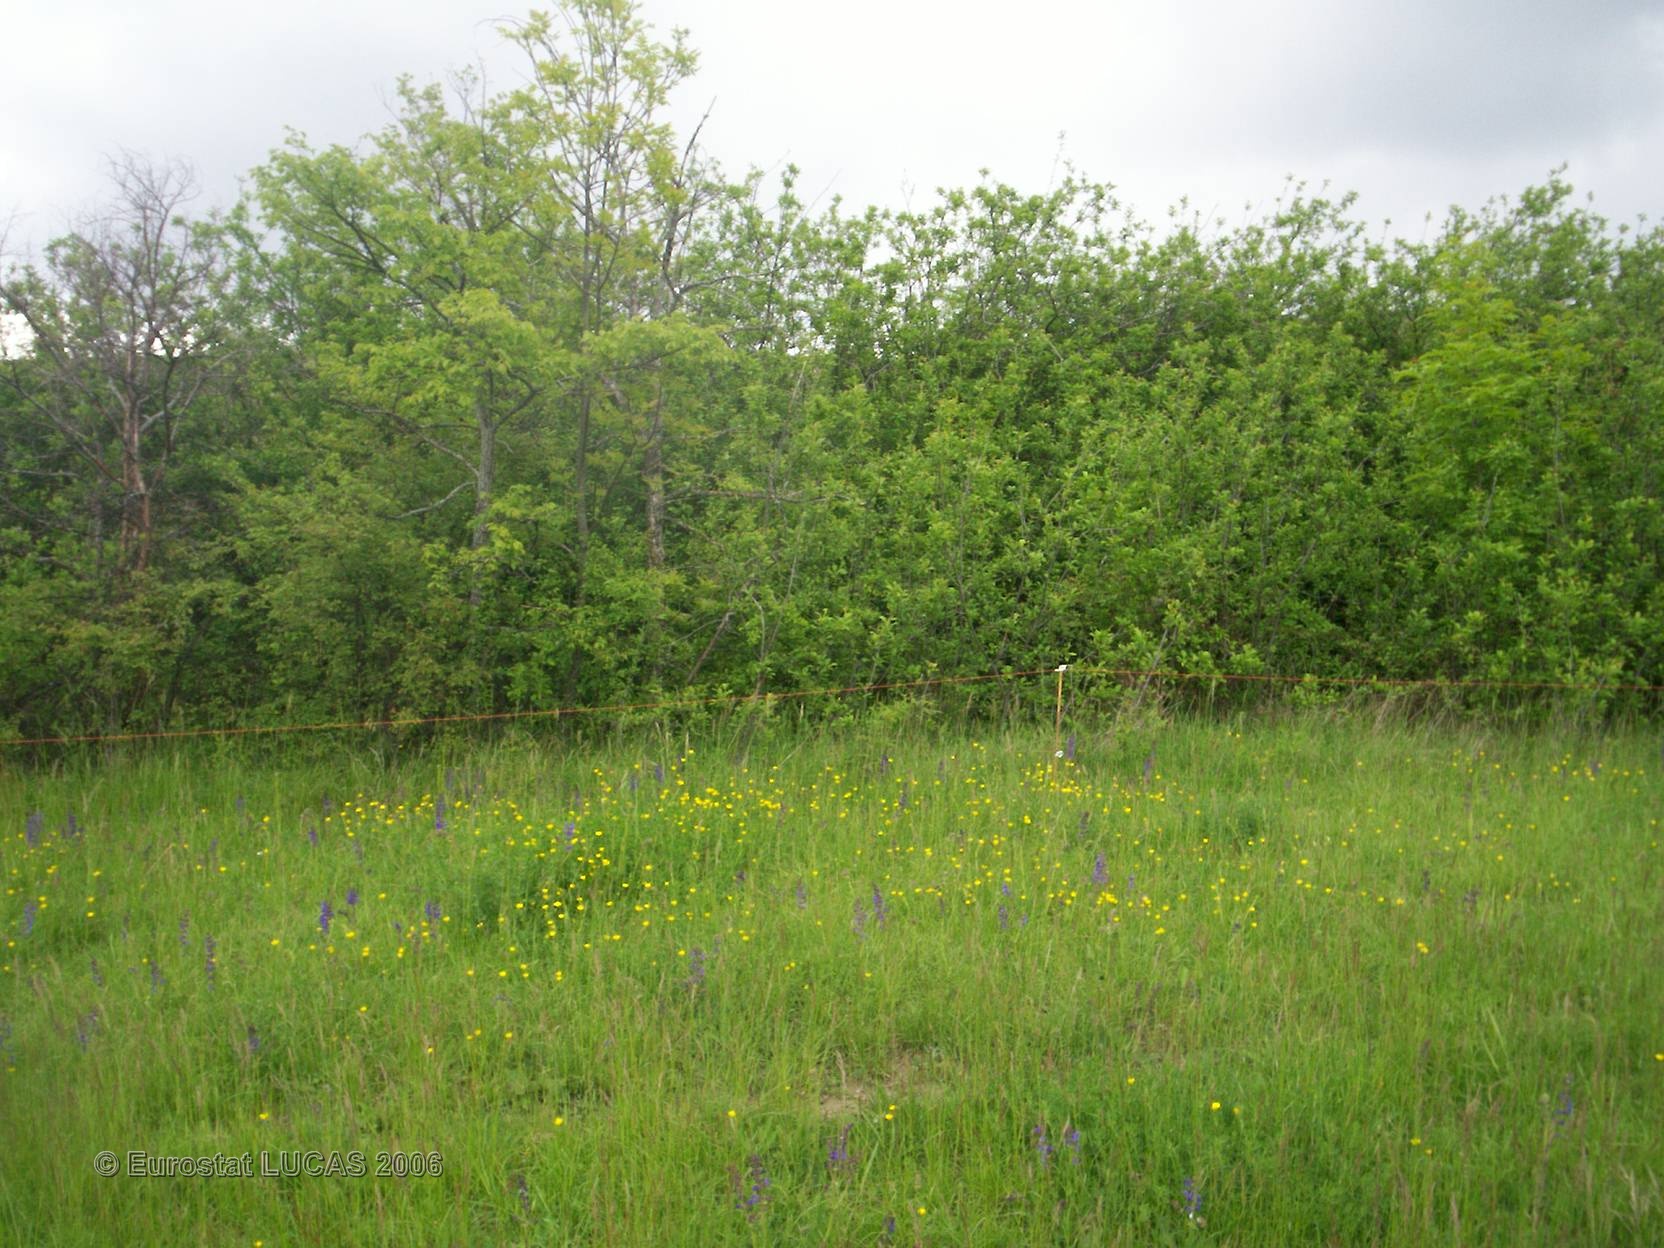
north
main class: Grassland
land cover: Grassland without tree/shrub cover
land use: Agriculture (excluding fallow land and kitchen gardens)
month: May
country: FR
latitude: 45.7143
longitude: 3.1272
